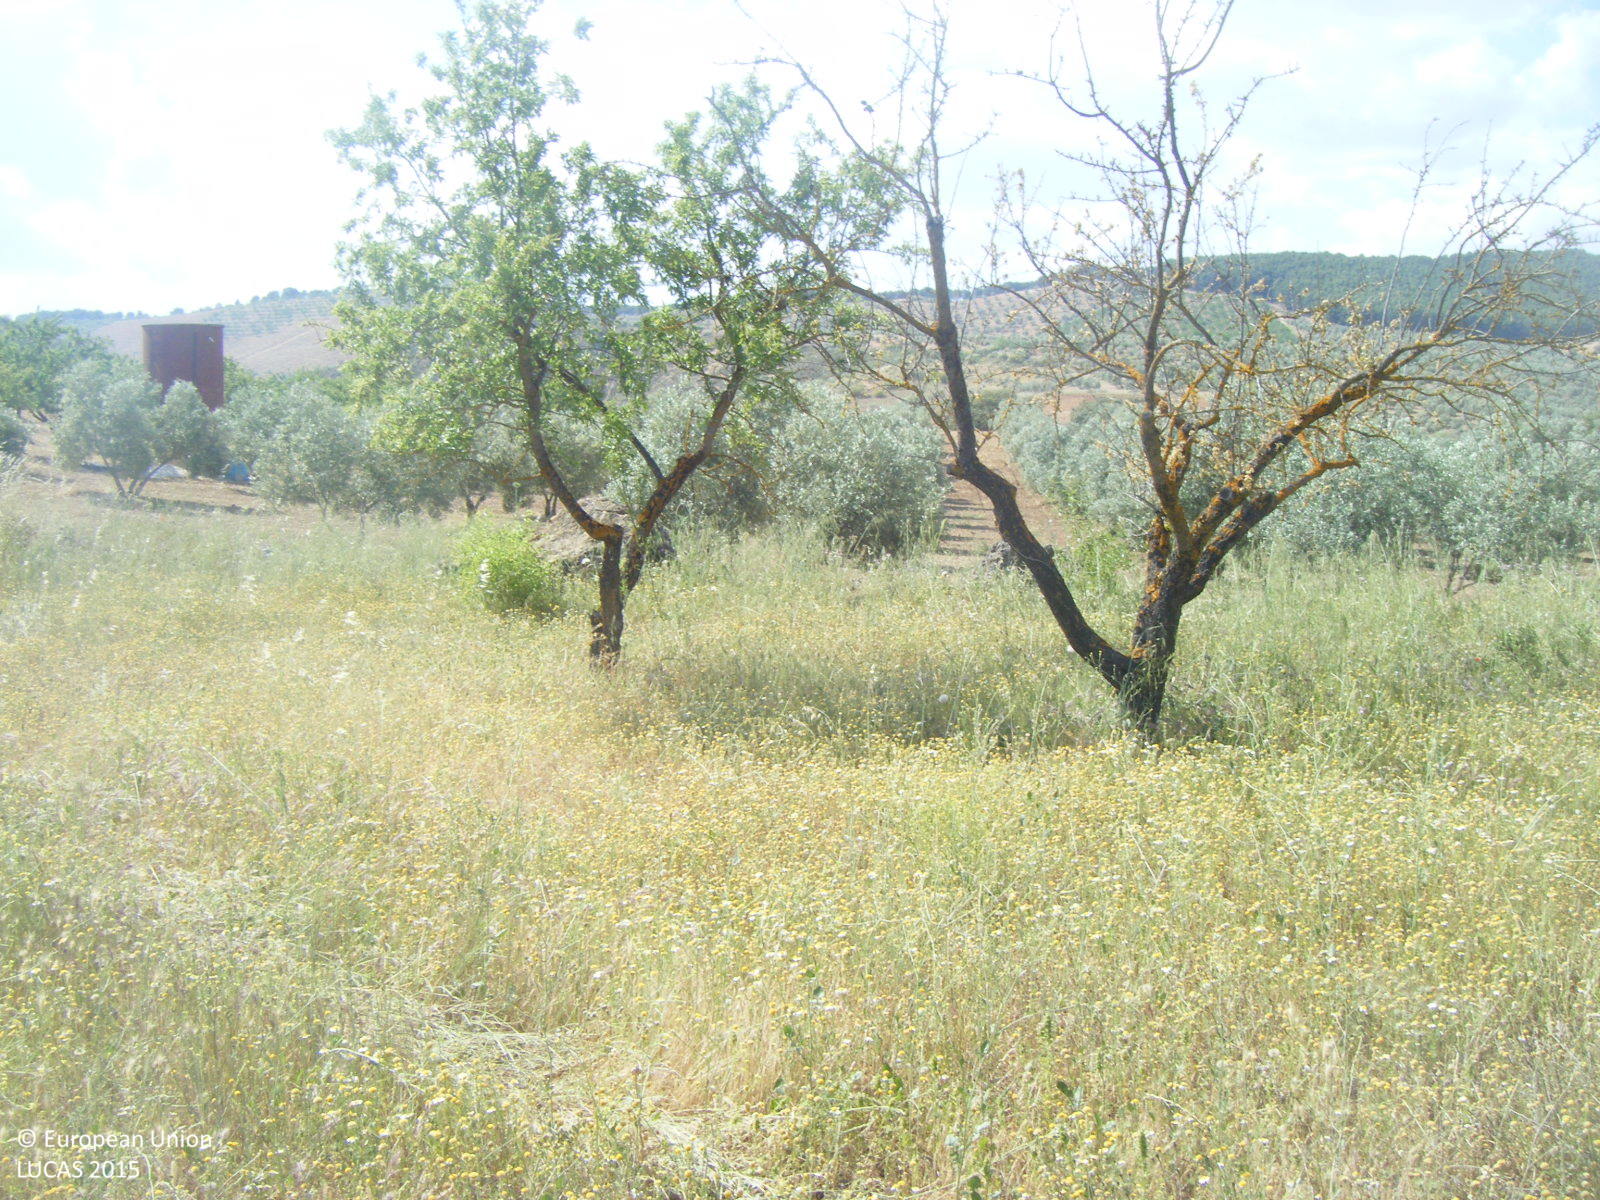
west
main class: Cropland
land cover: Nuts trees
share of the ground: 10 - 25 %
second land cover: Spontaneously vegetated surfaces
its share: > 75 %
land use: Agriculture (excluding fallow land and kitchen gardens)
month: May
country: ES
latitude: 37.0534
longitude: -4.3774
